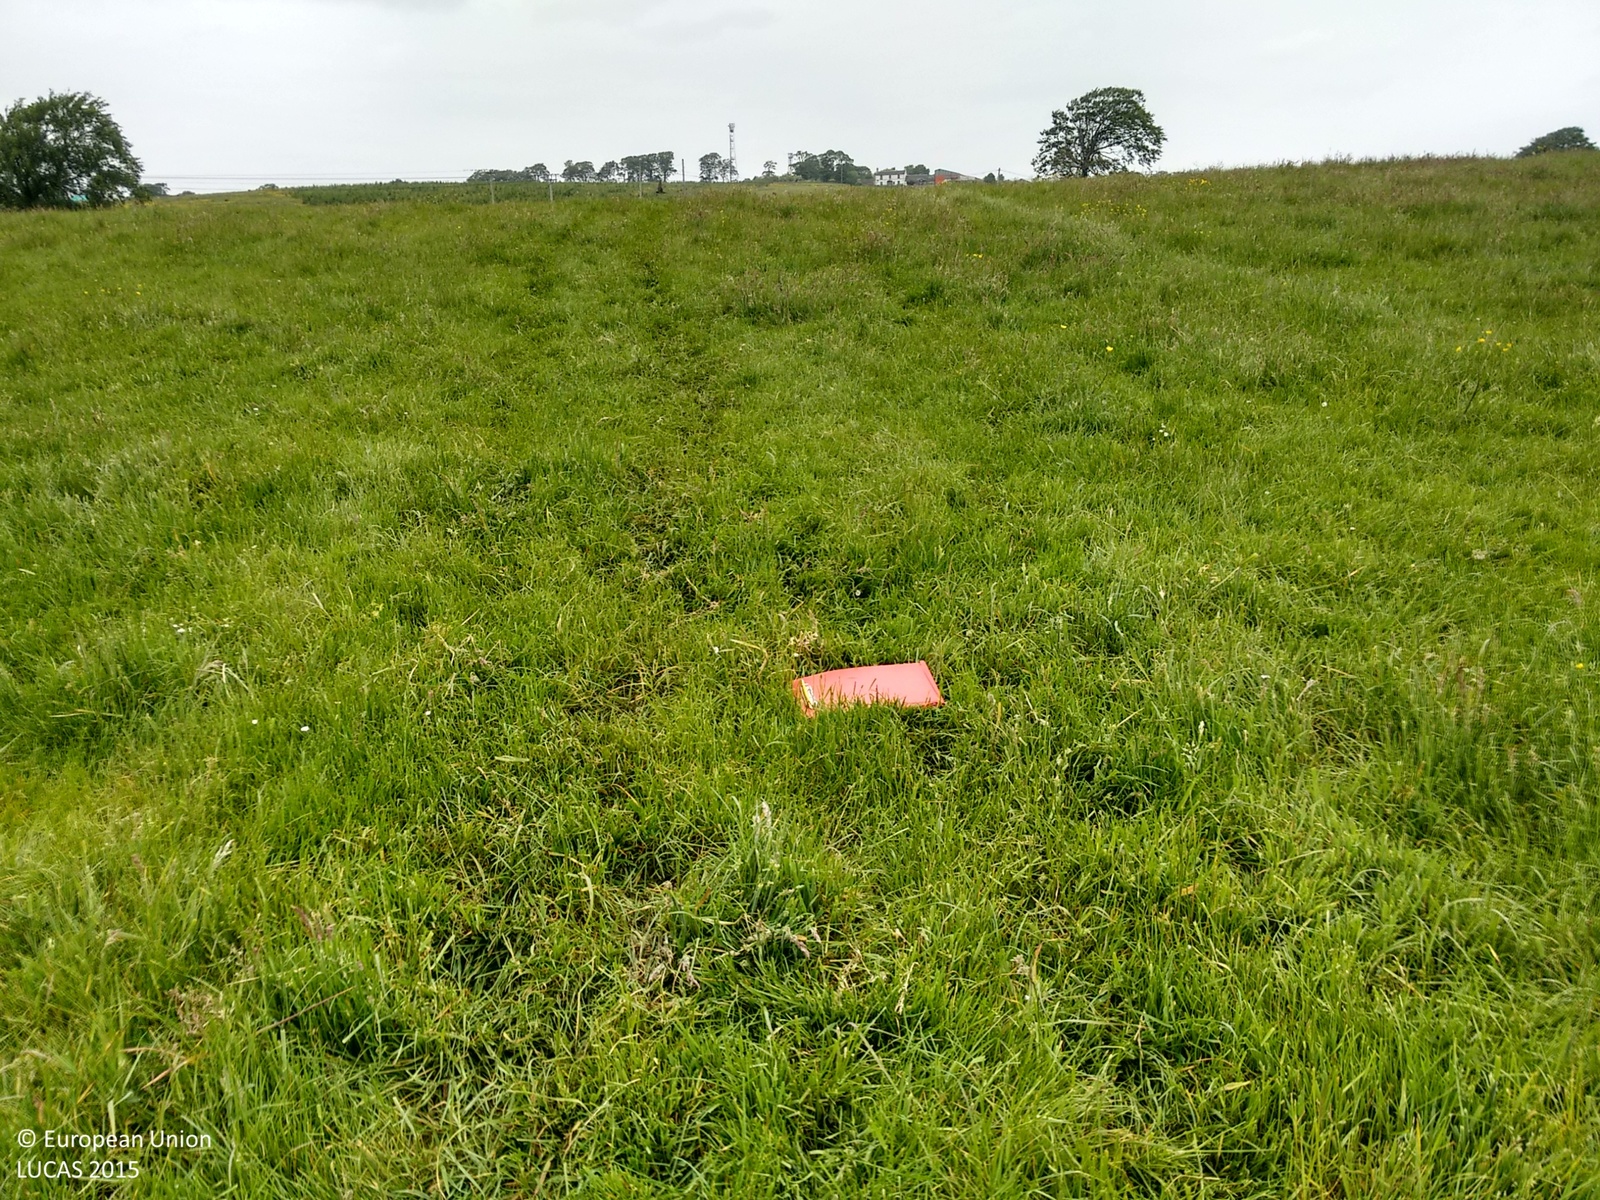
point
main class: Grassland
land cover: Grassland without tree/shrub cover
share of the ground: > 75 %
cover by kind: herbaceous plants 100 %
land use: Agriculture (excluding fallow land and kitchen gardens)
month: June
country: GB
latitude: 55.6319
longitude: -3.8571
